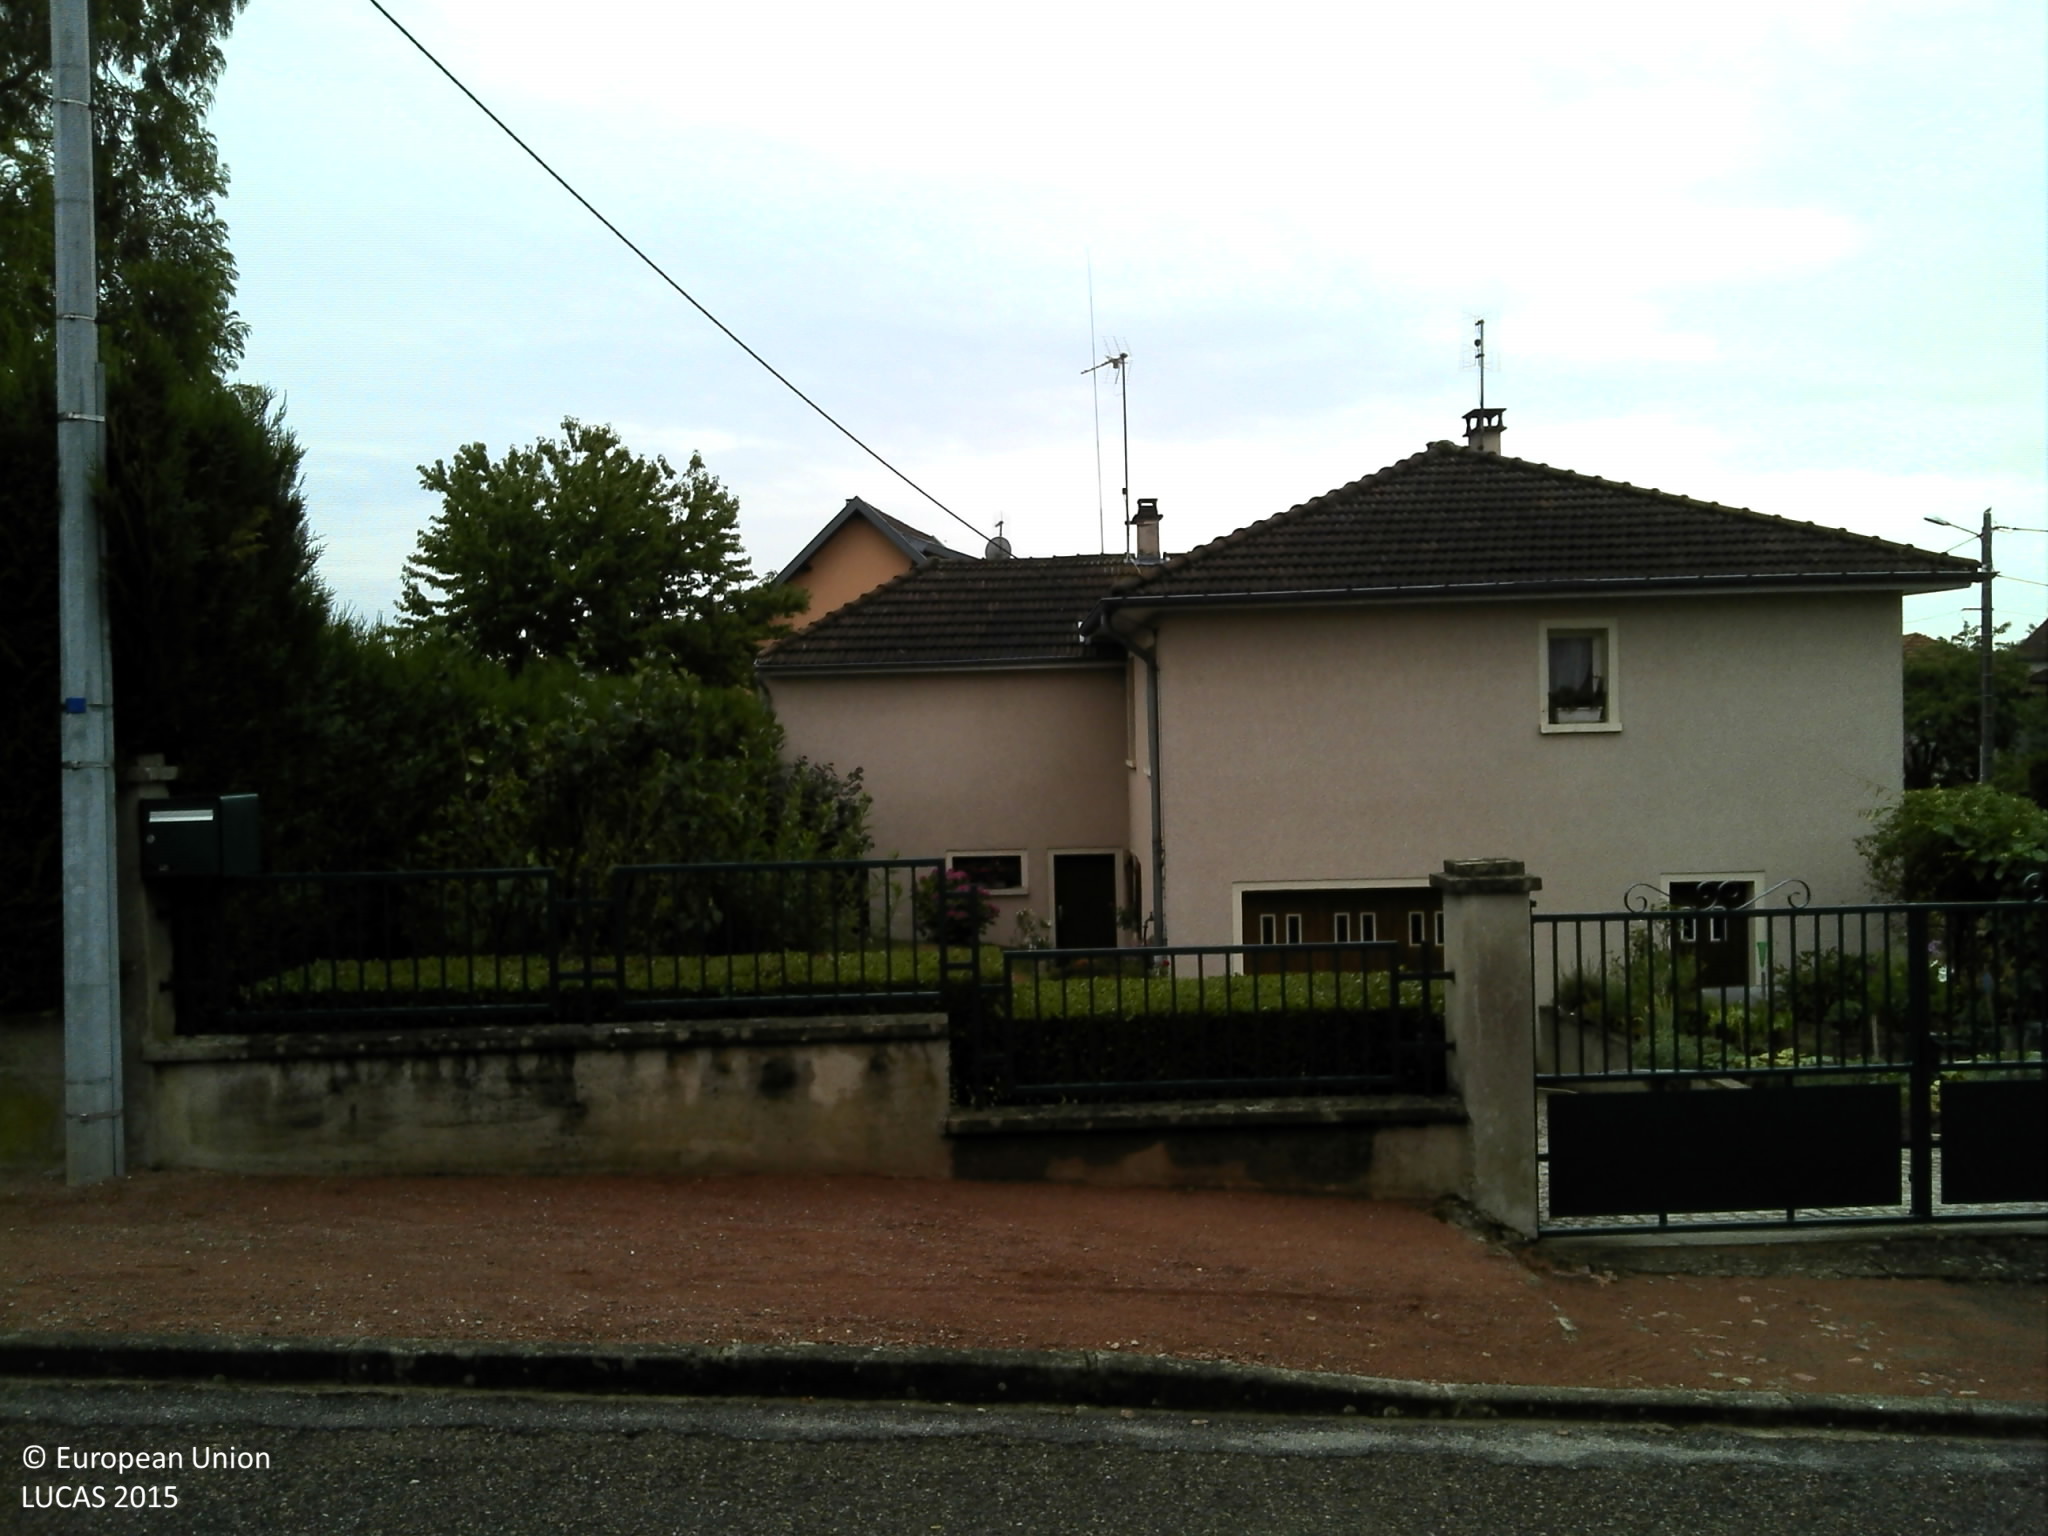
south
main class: Grassland
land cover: Grassland without tree/shrub cover
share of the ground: > 75 %
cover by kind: herbaceous plants 100 %
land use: Residential
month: August
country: FR
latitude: 46.1514
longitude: 4.0842
